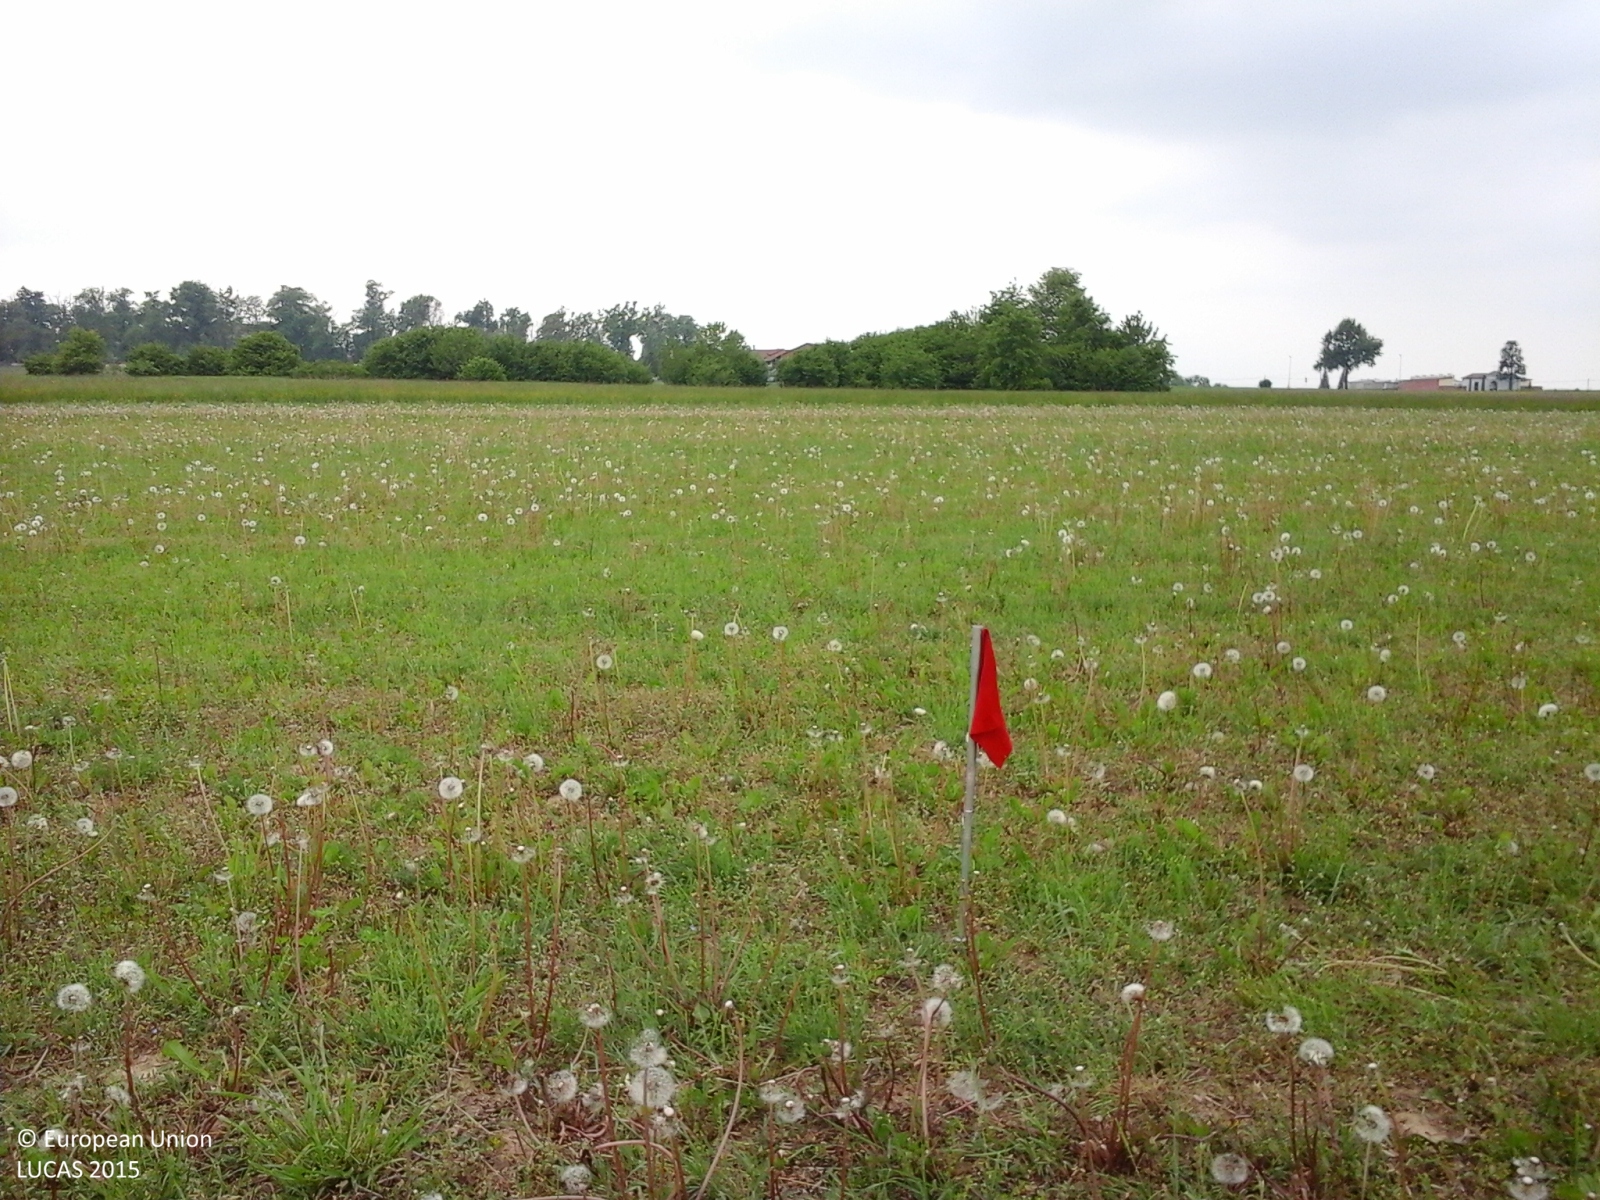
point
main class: Grassland
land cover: Spontaneously vegetated surfaces
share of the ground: 25 - 50 %
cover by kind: herbaceous plants 100 %
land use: Fallow land
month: May
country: IT
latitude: 44.5798
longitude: 7.8005
